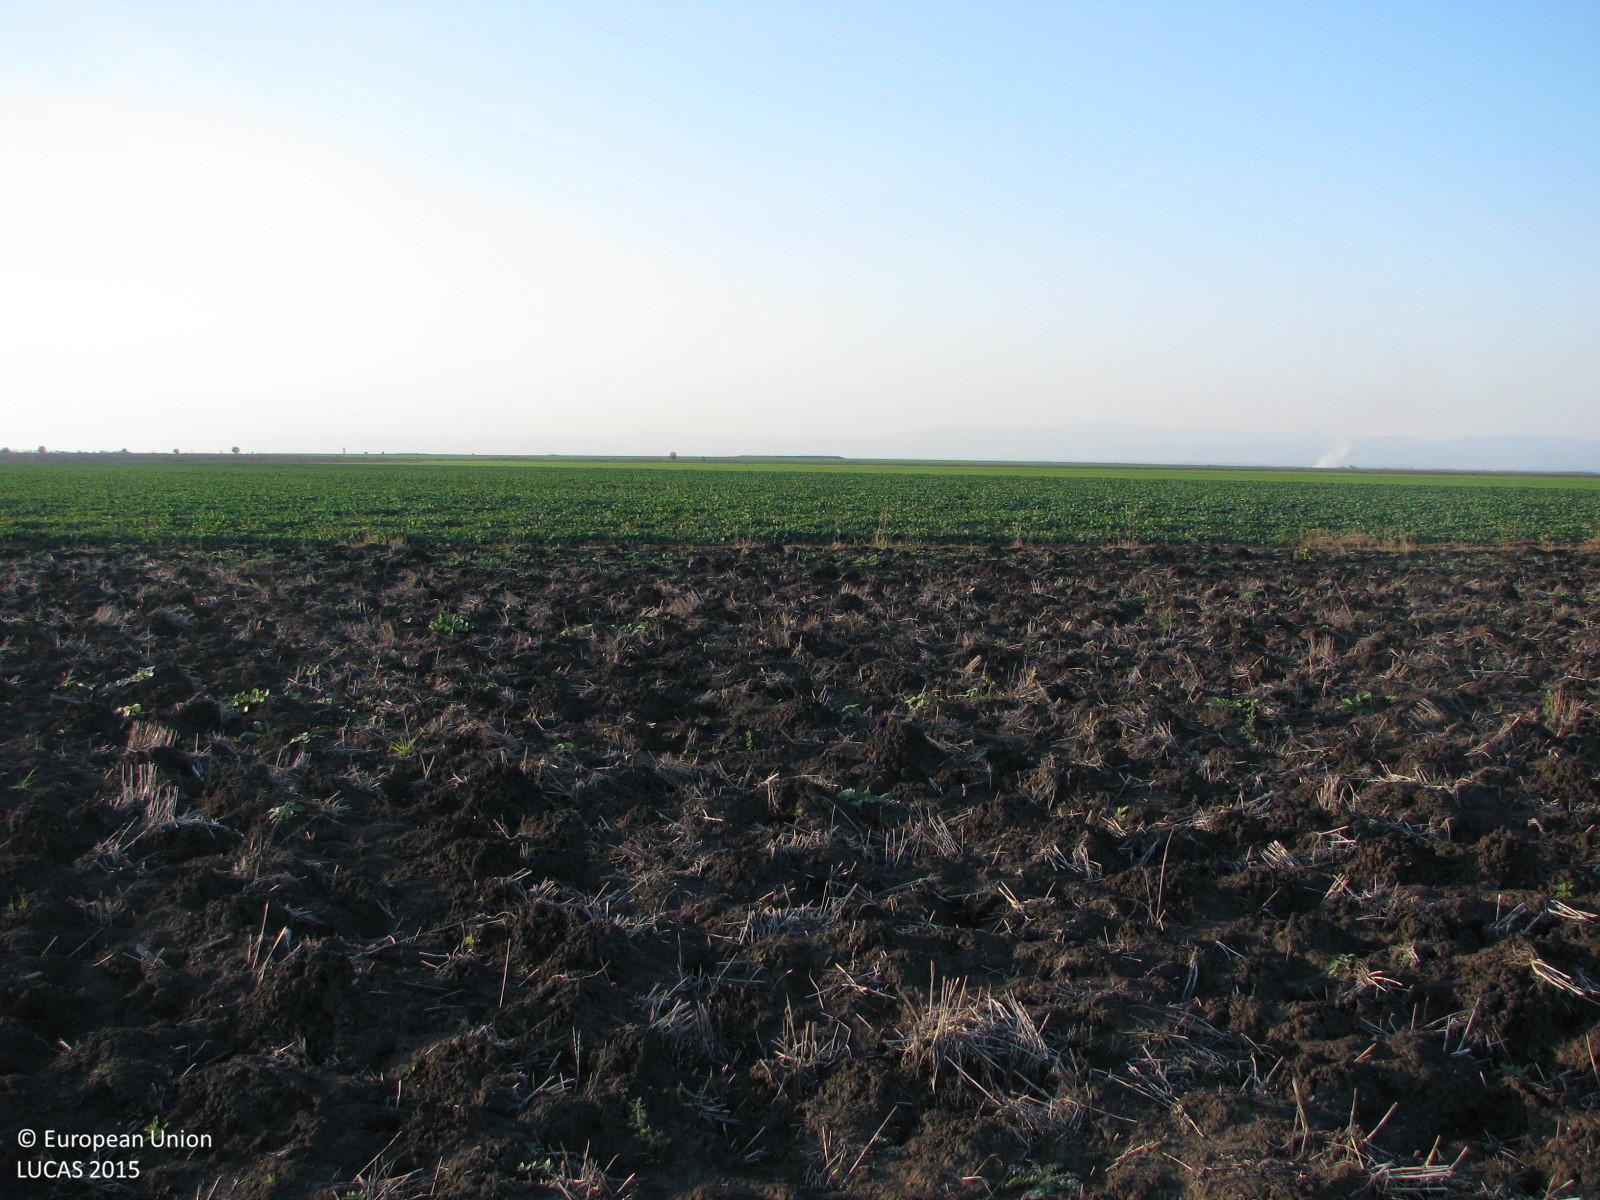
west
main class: Cropland
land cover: Common wheat
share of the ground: < 10 %
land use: Agriculture (excluding fallow land and kitchen gardens)
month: November
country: BG
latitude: 42.3436
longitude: 26.0168
